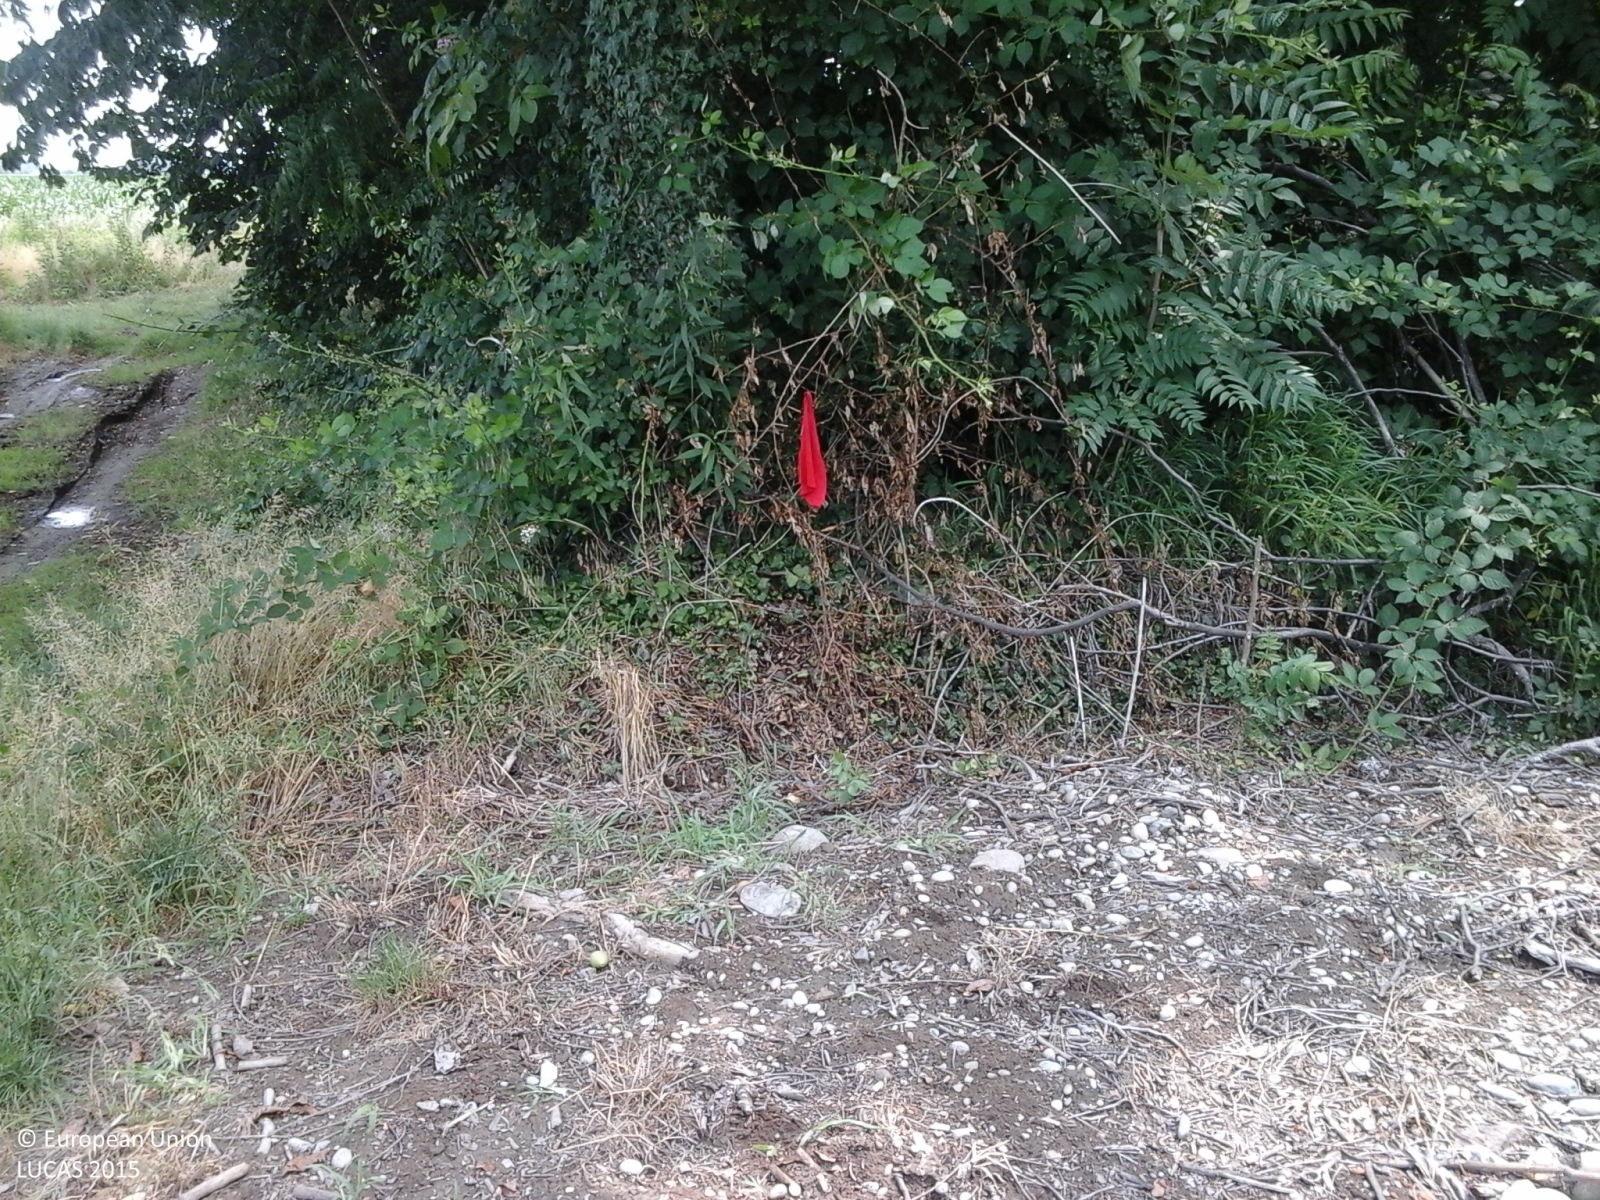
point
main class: Woodland
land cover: Broadleaved woodland
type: thermophilous deciduous forest
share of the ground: > 75 %
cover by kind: broadleaved forest trees 100 %
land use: Forestry
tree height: > 5 m
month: June
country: IT
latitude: 45.4927
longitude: 8.4287
